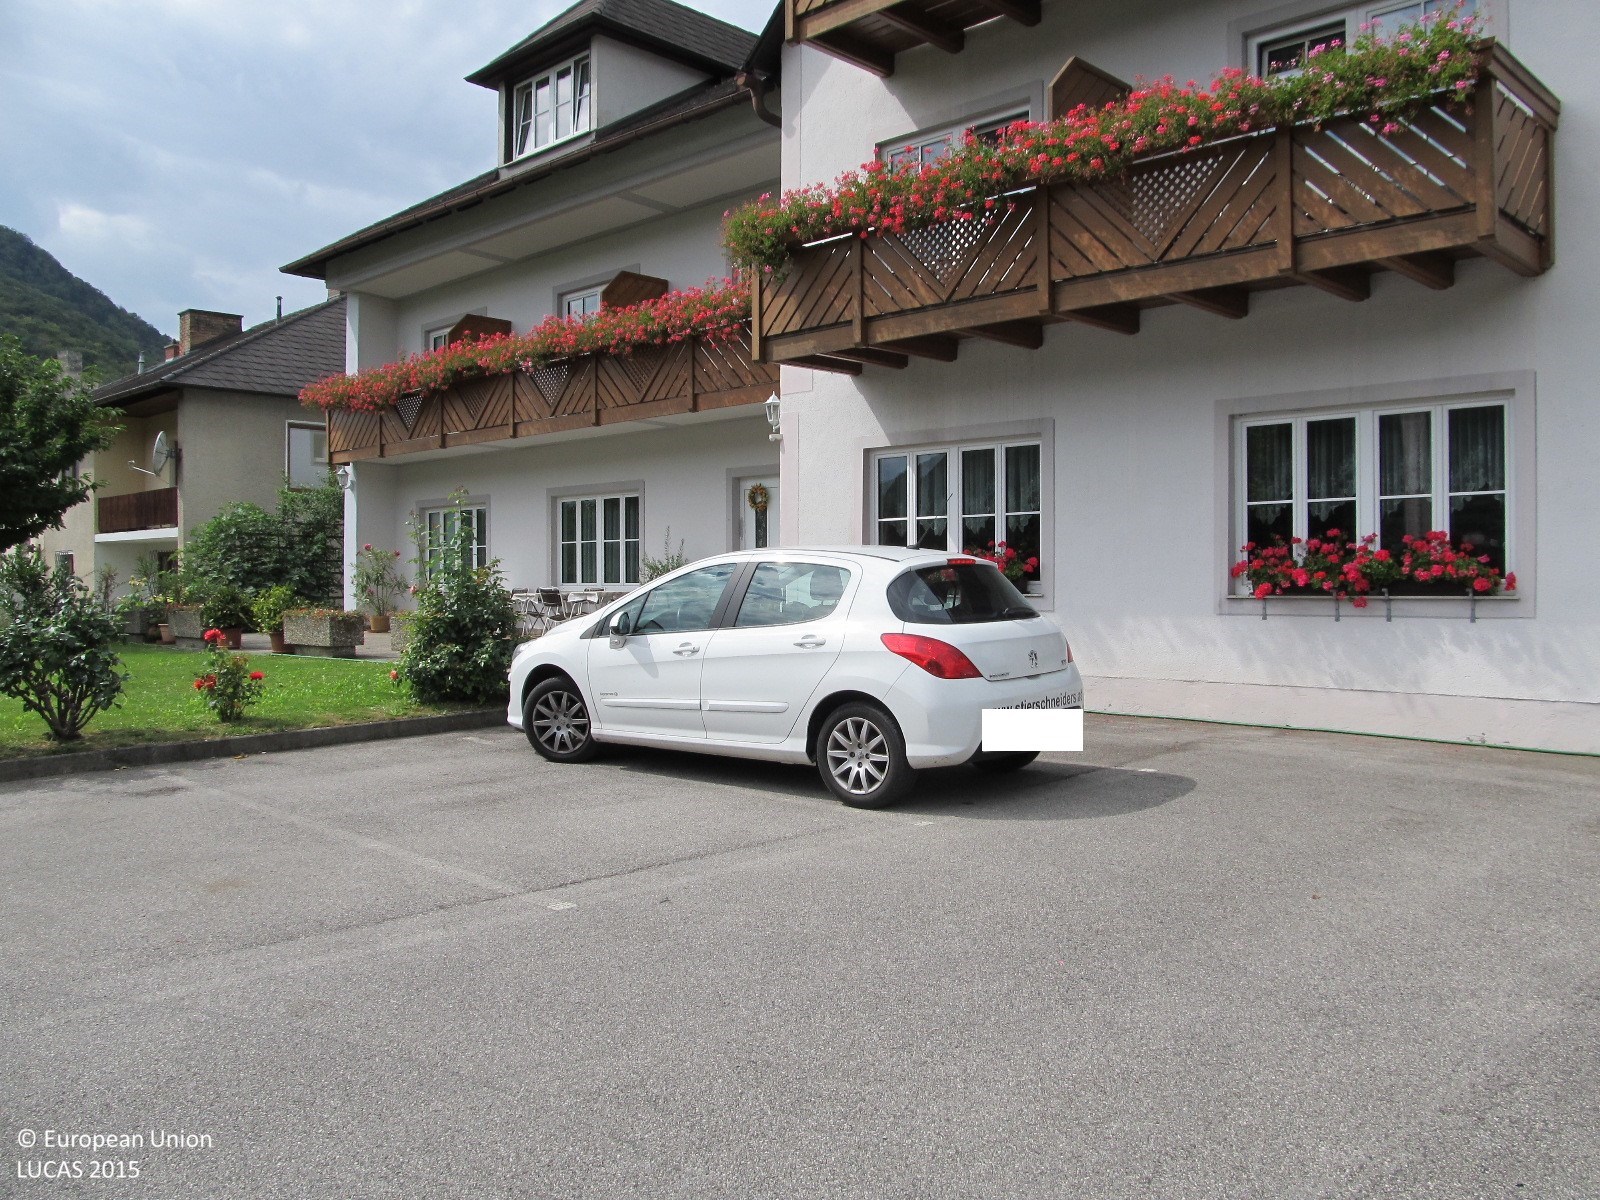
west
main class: Grassland
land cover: Grassland without tree/shrub cover
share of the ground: > 75 %
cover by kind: herbaceous plants 100 %
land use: Residential
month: September
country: AT
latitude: 48.3610
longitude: 15.4146
